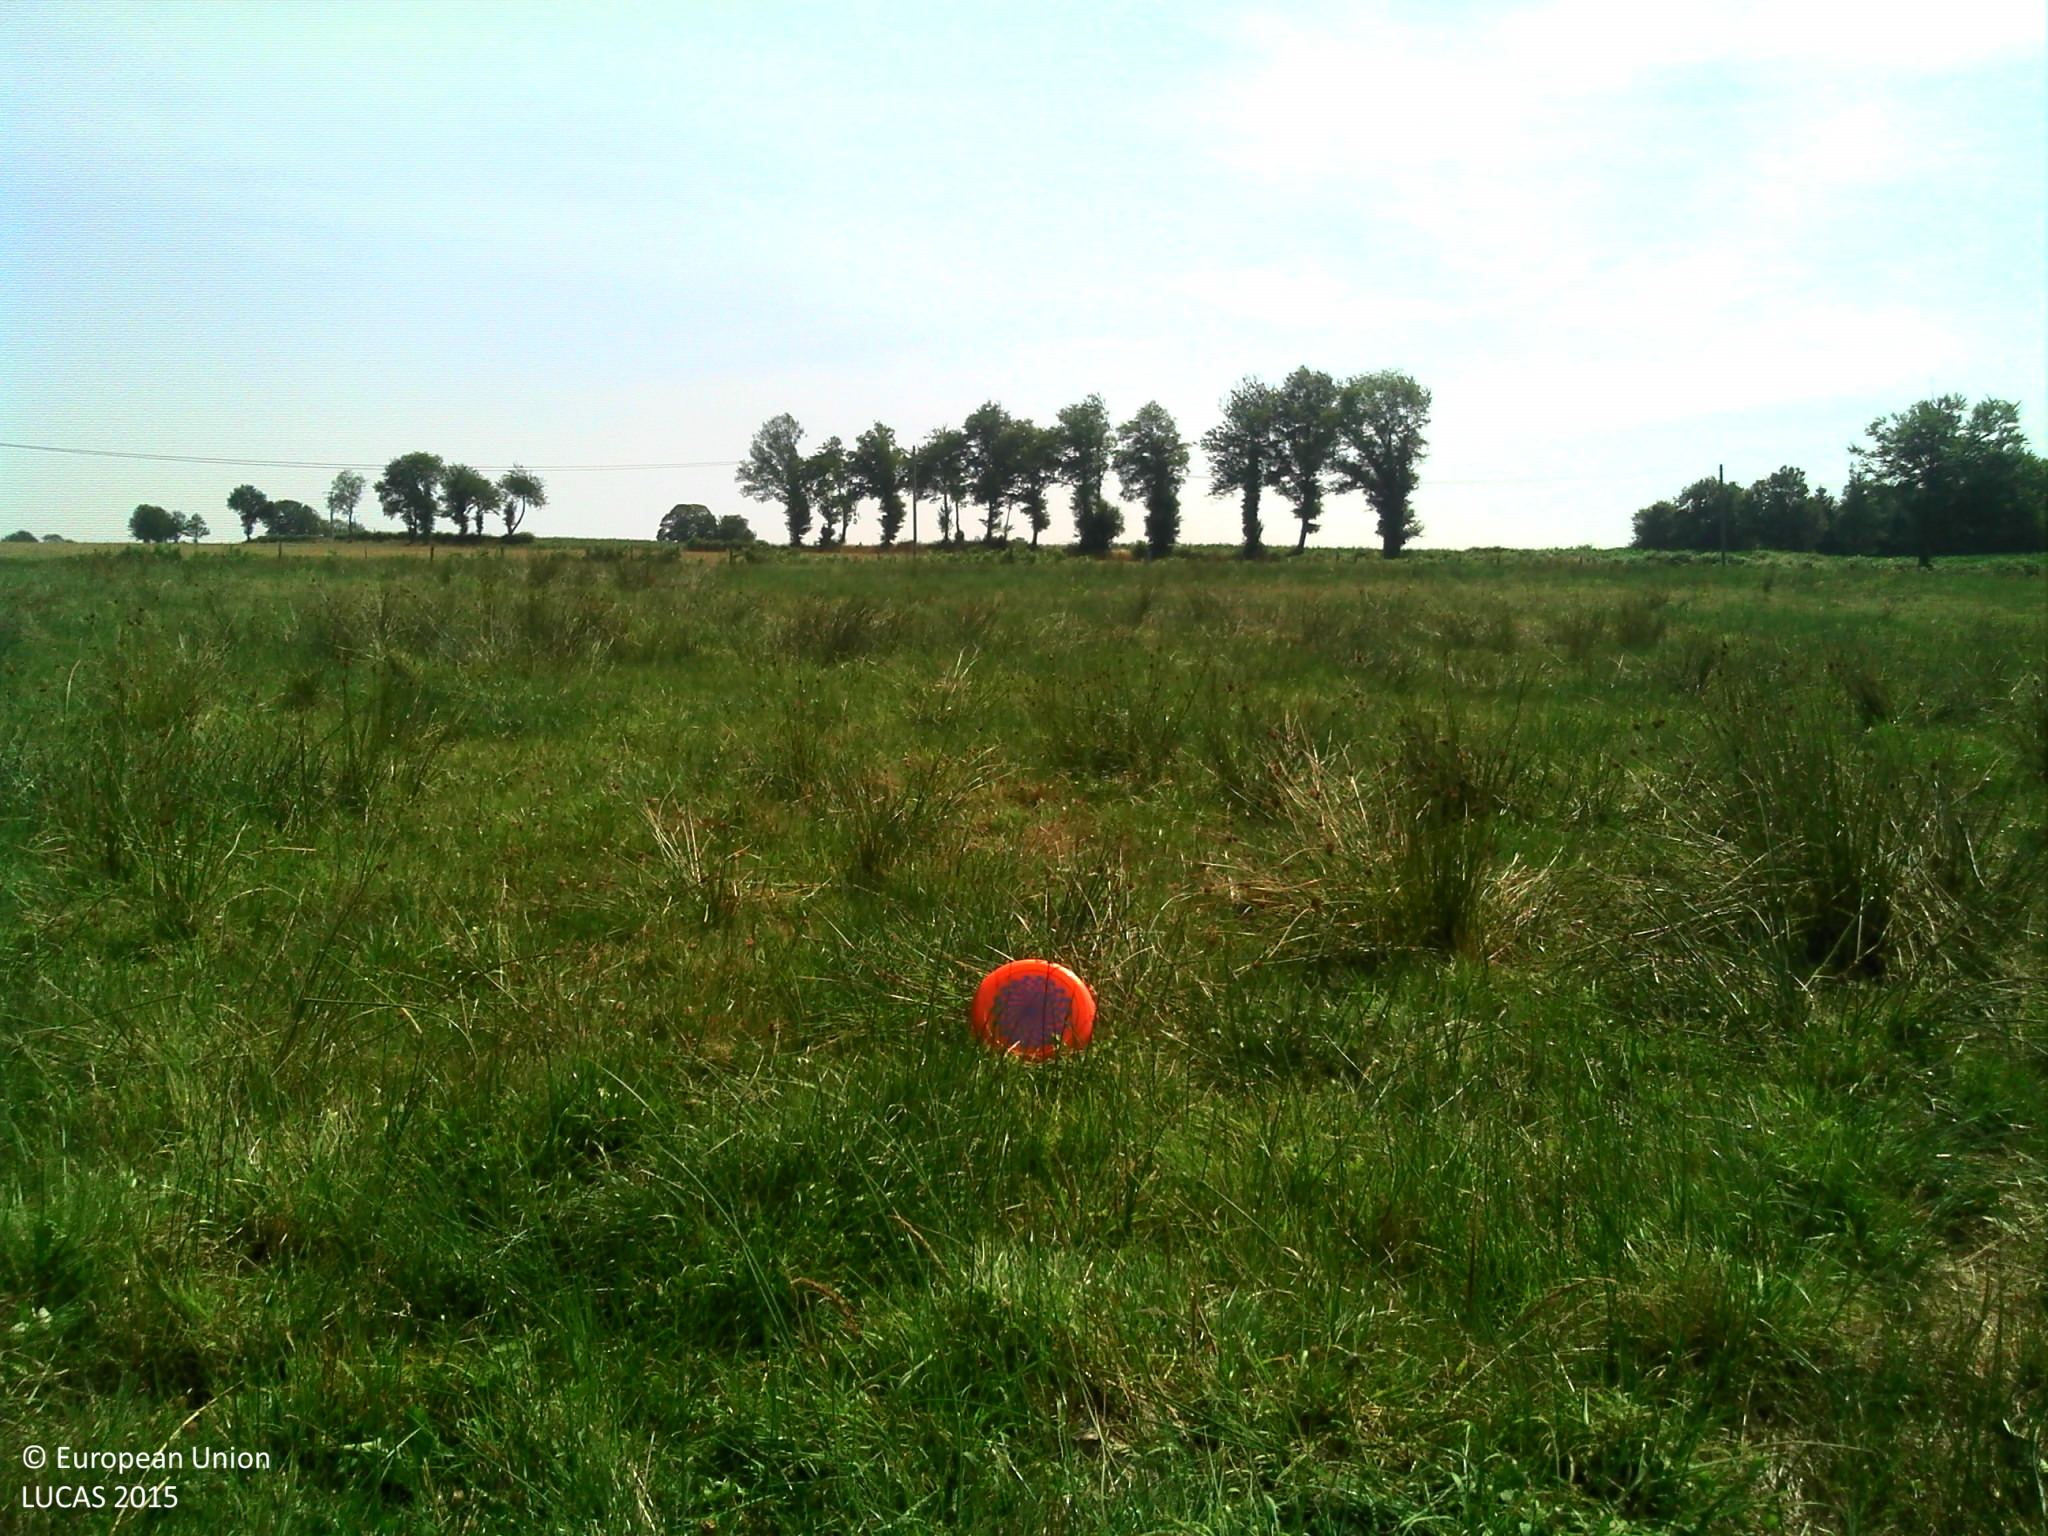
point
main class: Grassland
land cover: Grassland without tree/shrub cover
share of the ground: > 75 %
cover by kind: herbaceous plants 95 %, shrubs 5 %
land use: Agriculture (excluding fallow land and kitchen gardens)
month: July
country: FR
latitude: 46.0470
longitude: 1.7087
